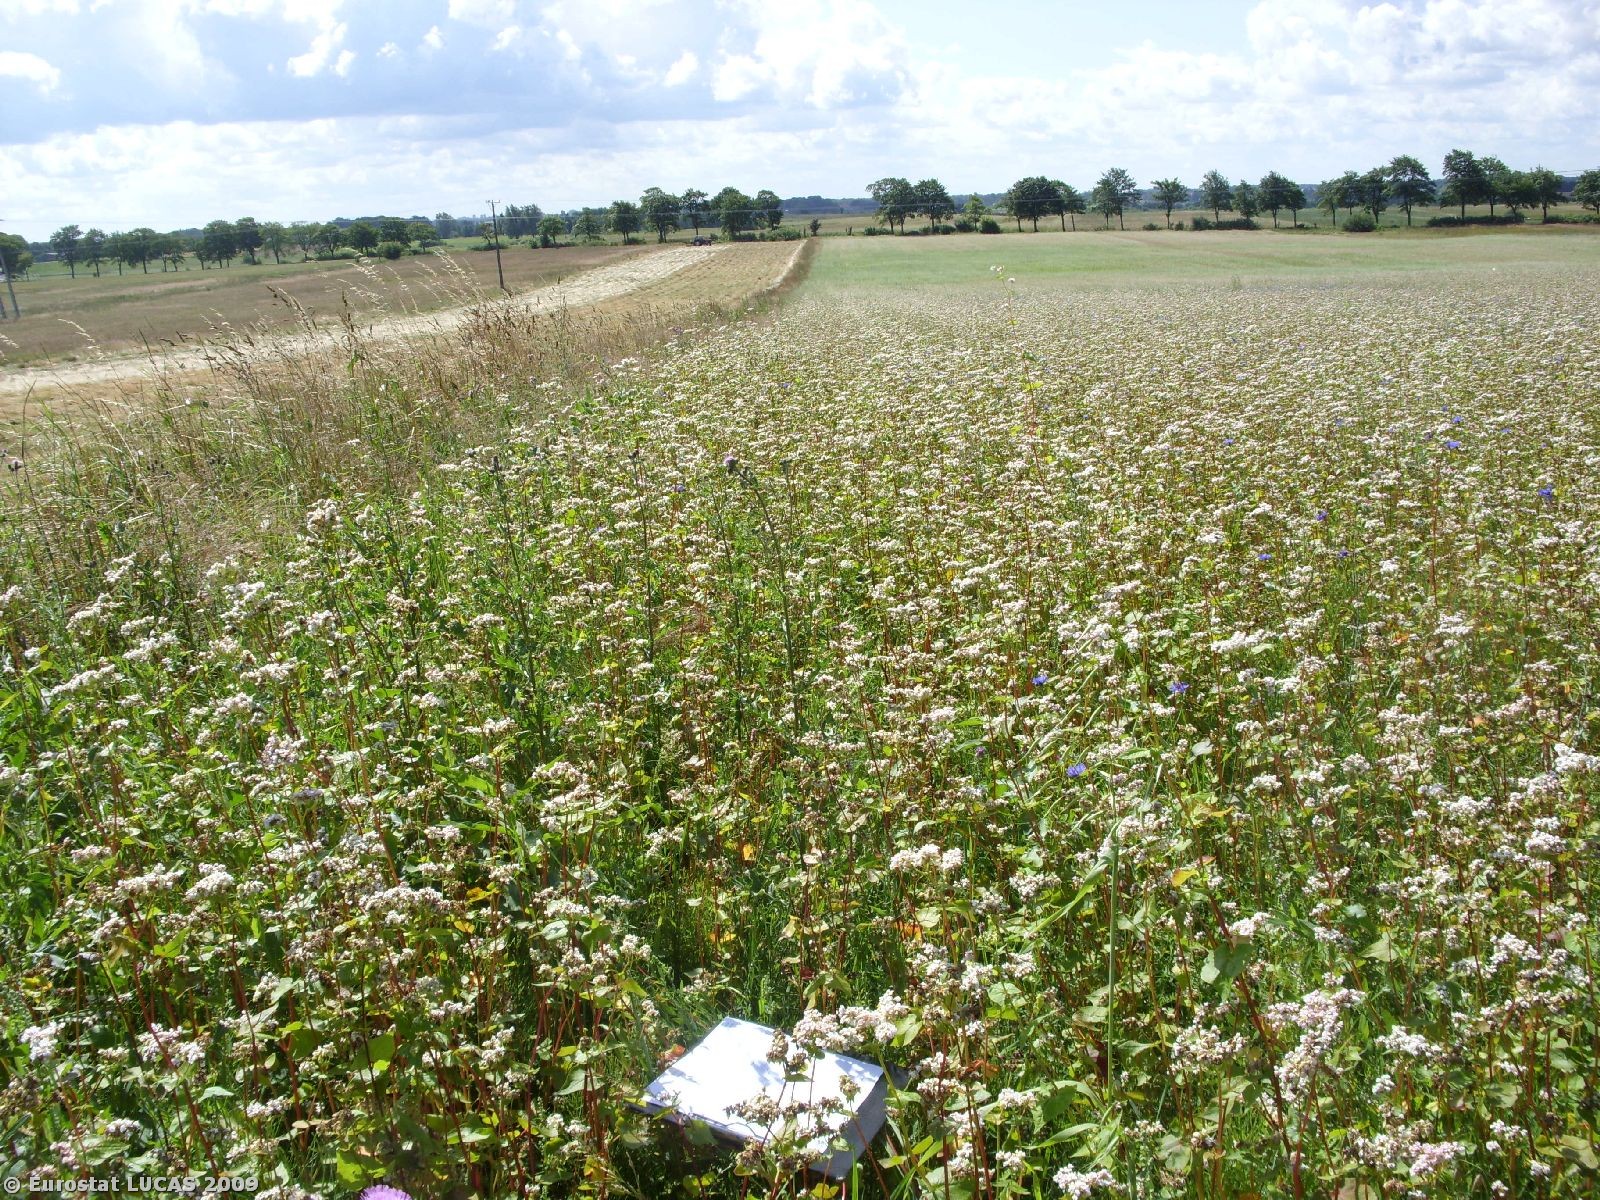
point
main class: Cropland
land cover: Other cereals
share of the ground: > 75 %
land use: Agriculture (excluding fallow land and kitchen gardens)
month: July
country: PL
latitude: 54.2444
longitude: 16.0044
